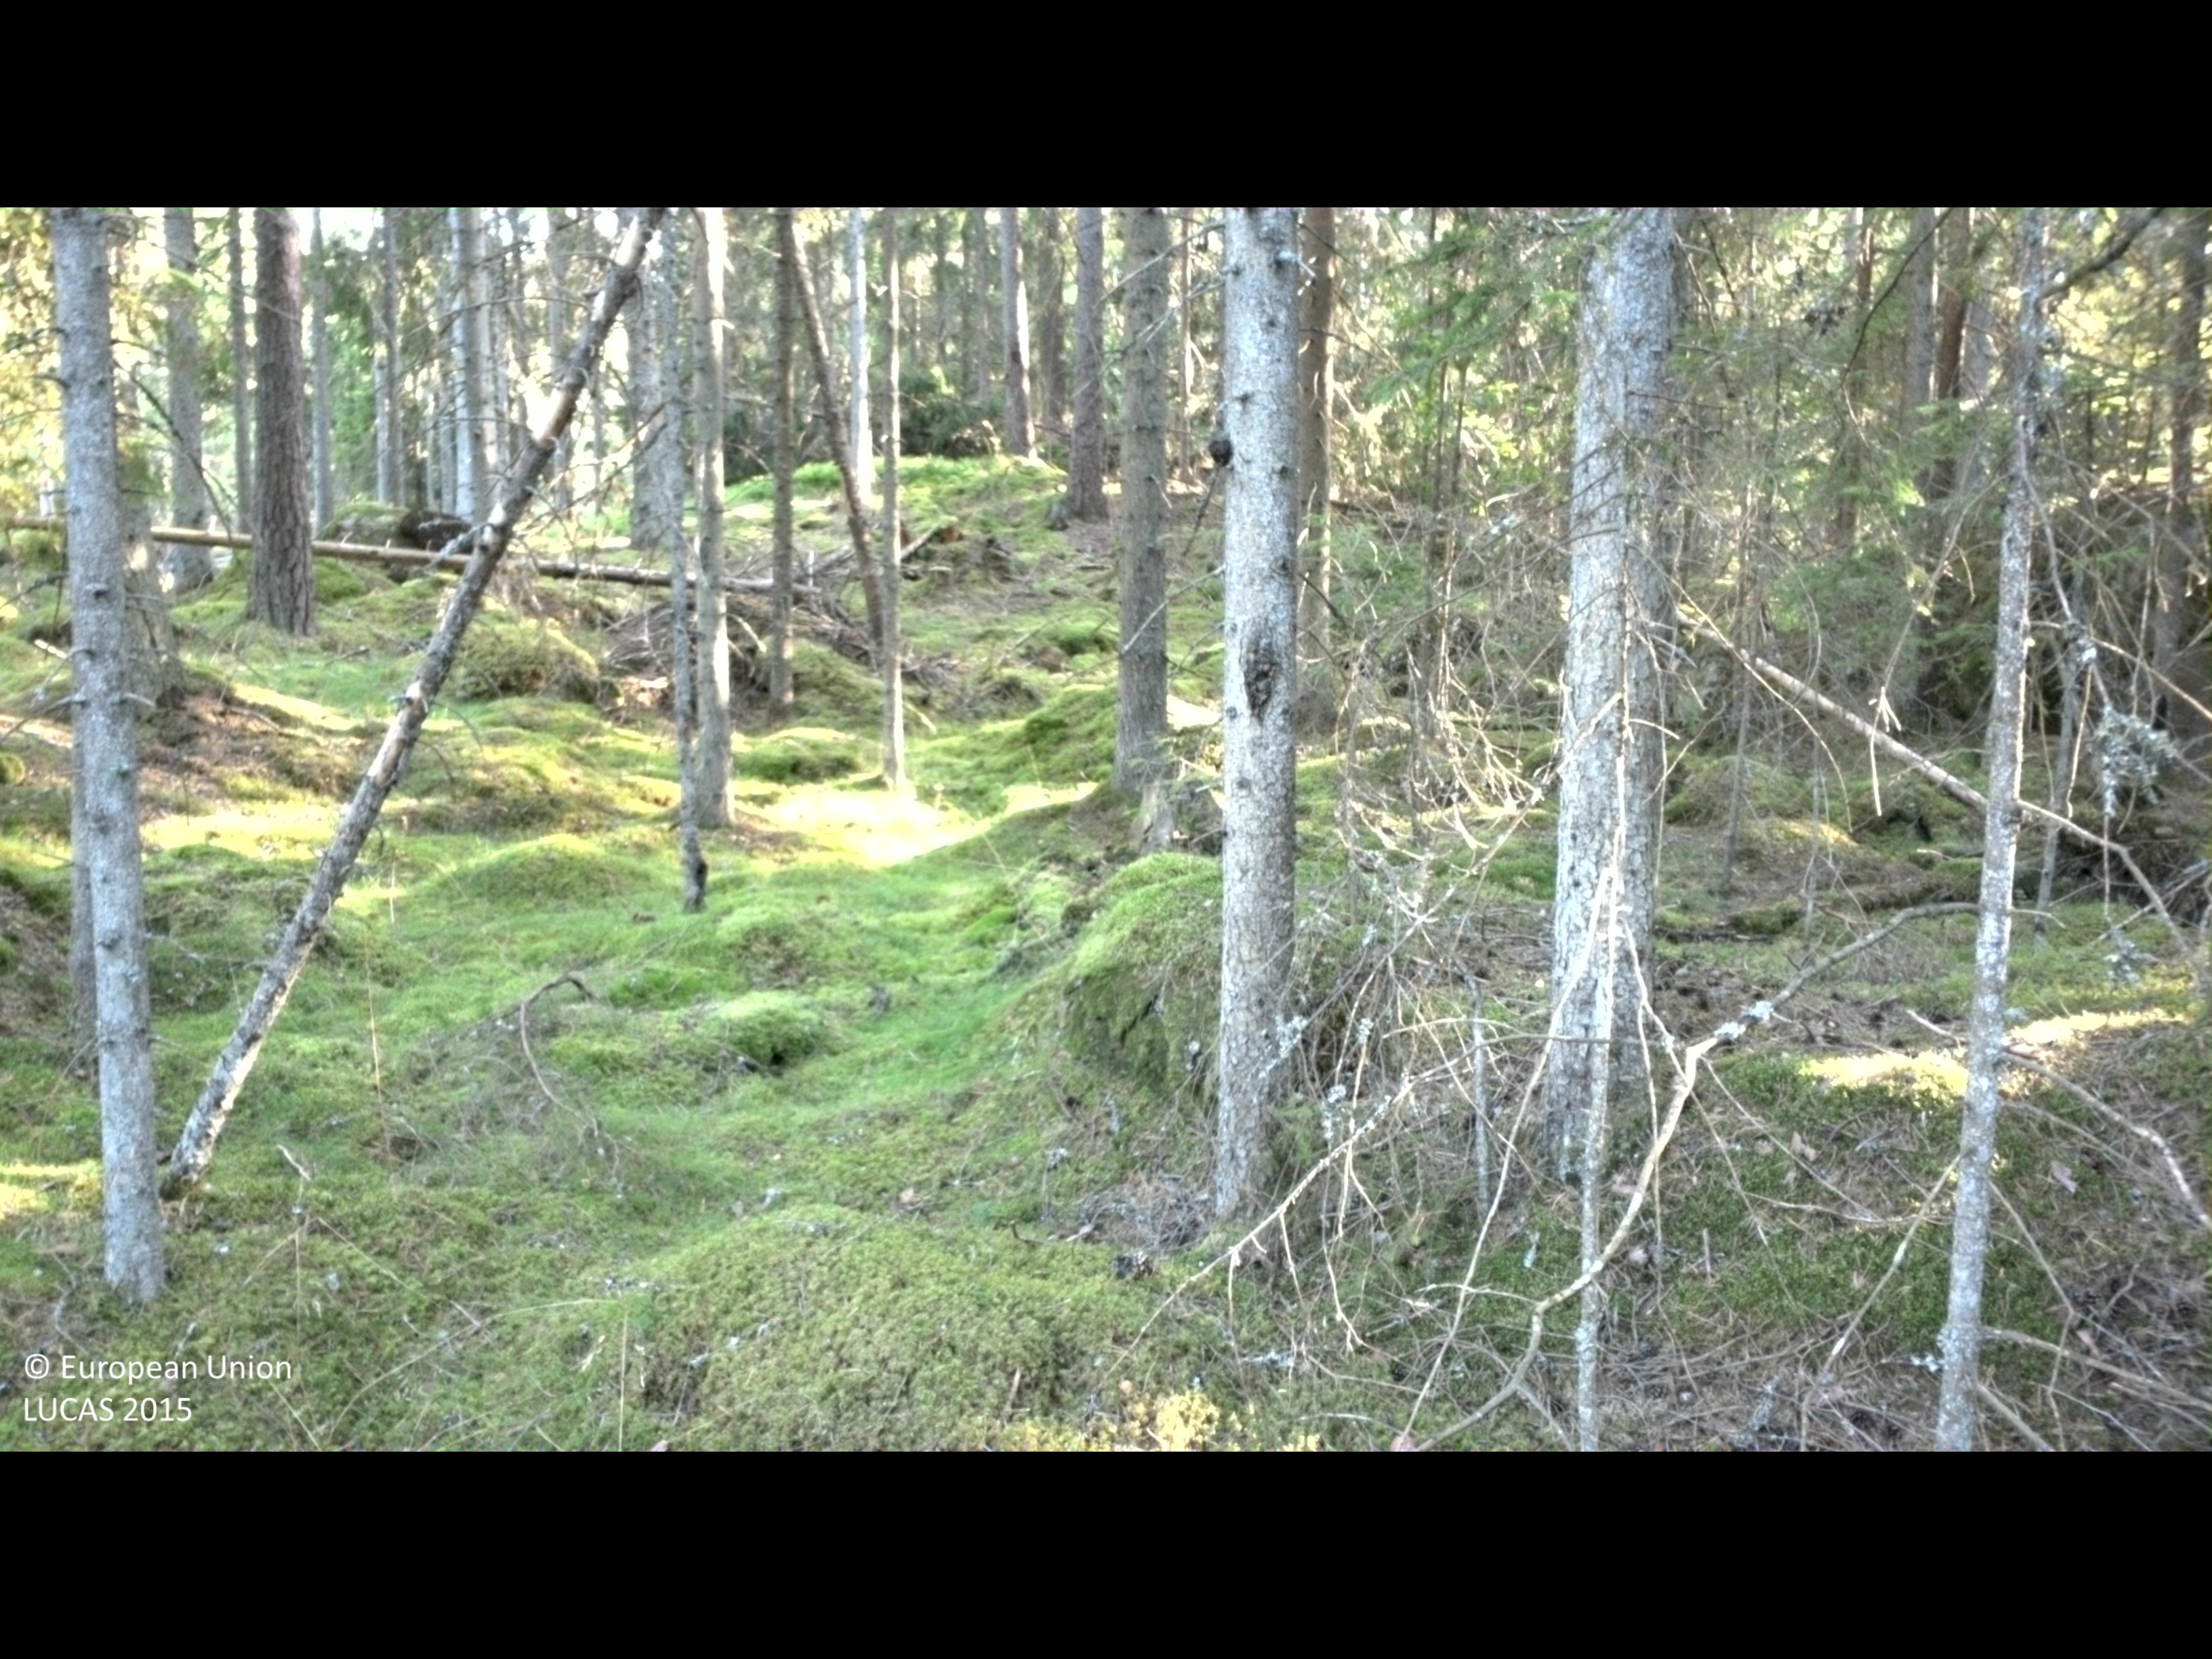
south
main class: Woodland
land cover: Spruce dominated coniferous woodland
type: boreal forest
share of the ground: 50 - 75 %
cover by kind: coniferous forest trees 60 %, lichens and mosses 40 %
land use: Forestry
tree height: > 5 m
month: August
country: SE
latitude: 56.2627
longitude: 14.2113
